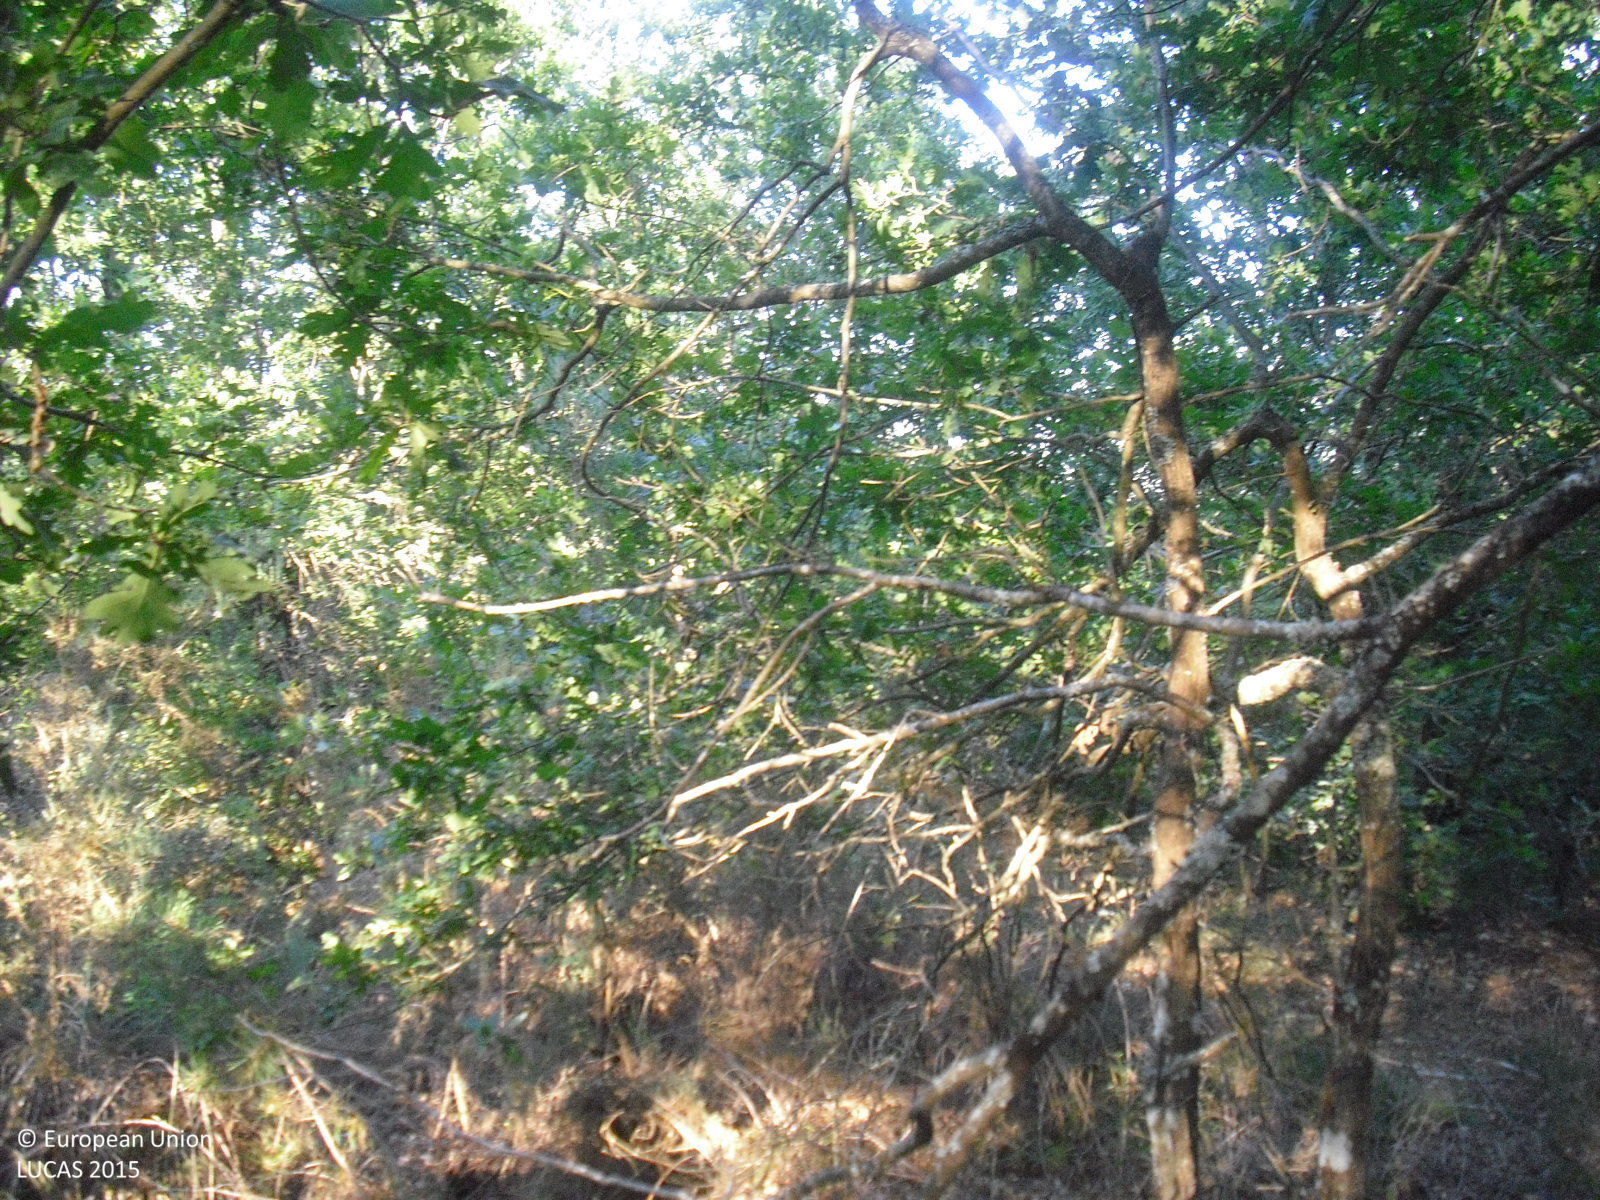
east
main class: Woodland
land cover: Pine dominated mixed woodland
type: hemiboreal forest and nemoral coniferous forest and mixed broadleaved-coniferous forest
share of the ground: > 75 %
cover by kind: coniferous forest trees 60 %, broadleaved forest trees 30 %, shrubs 10 %
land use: Forestry
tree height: > 5 m
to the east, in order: Pine dominated mixed woodland; Broadleaved woodland; Shrubland with sparse tree cover; Broadleaved woodland; Tracks; Broadleaved woodland; Shrubland with sparse tree cover; Paved roads, cycling and walking lanes; Grassland without tree/shrub cover; Fences; Groves; Dry stone walls; Shruby margins; Paved roads, cycling and walking lanes; Dry stone walls; Broadleaved woodland; Tracks; Broadleaved woodland; Shrubland without tree cover; Grassland without tree/shrub cover
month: July
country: ES
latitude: 42.6114
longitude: -7.4901
